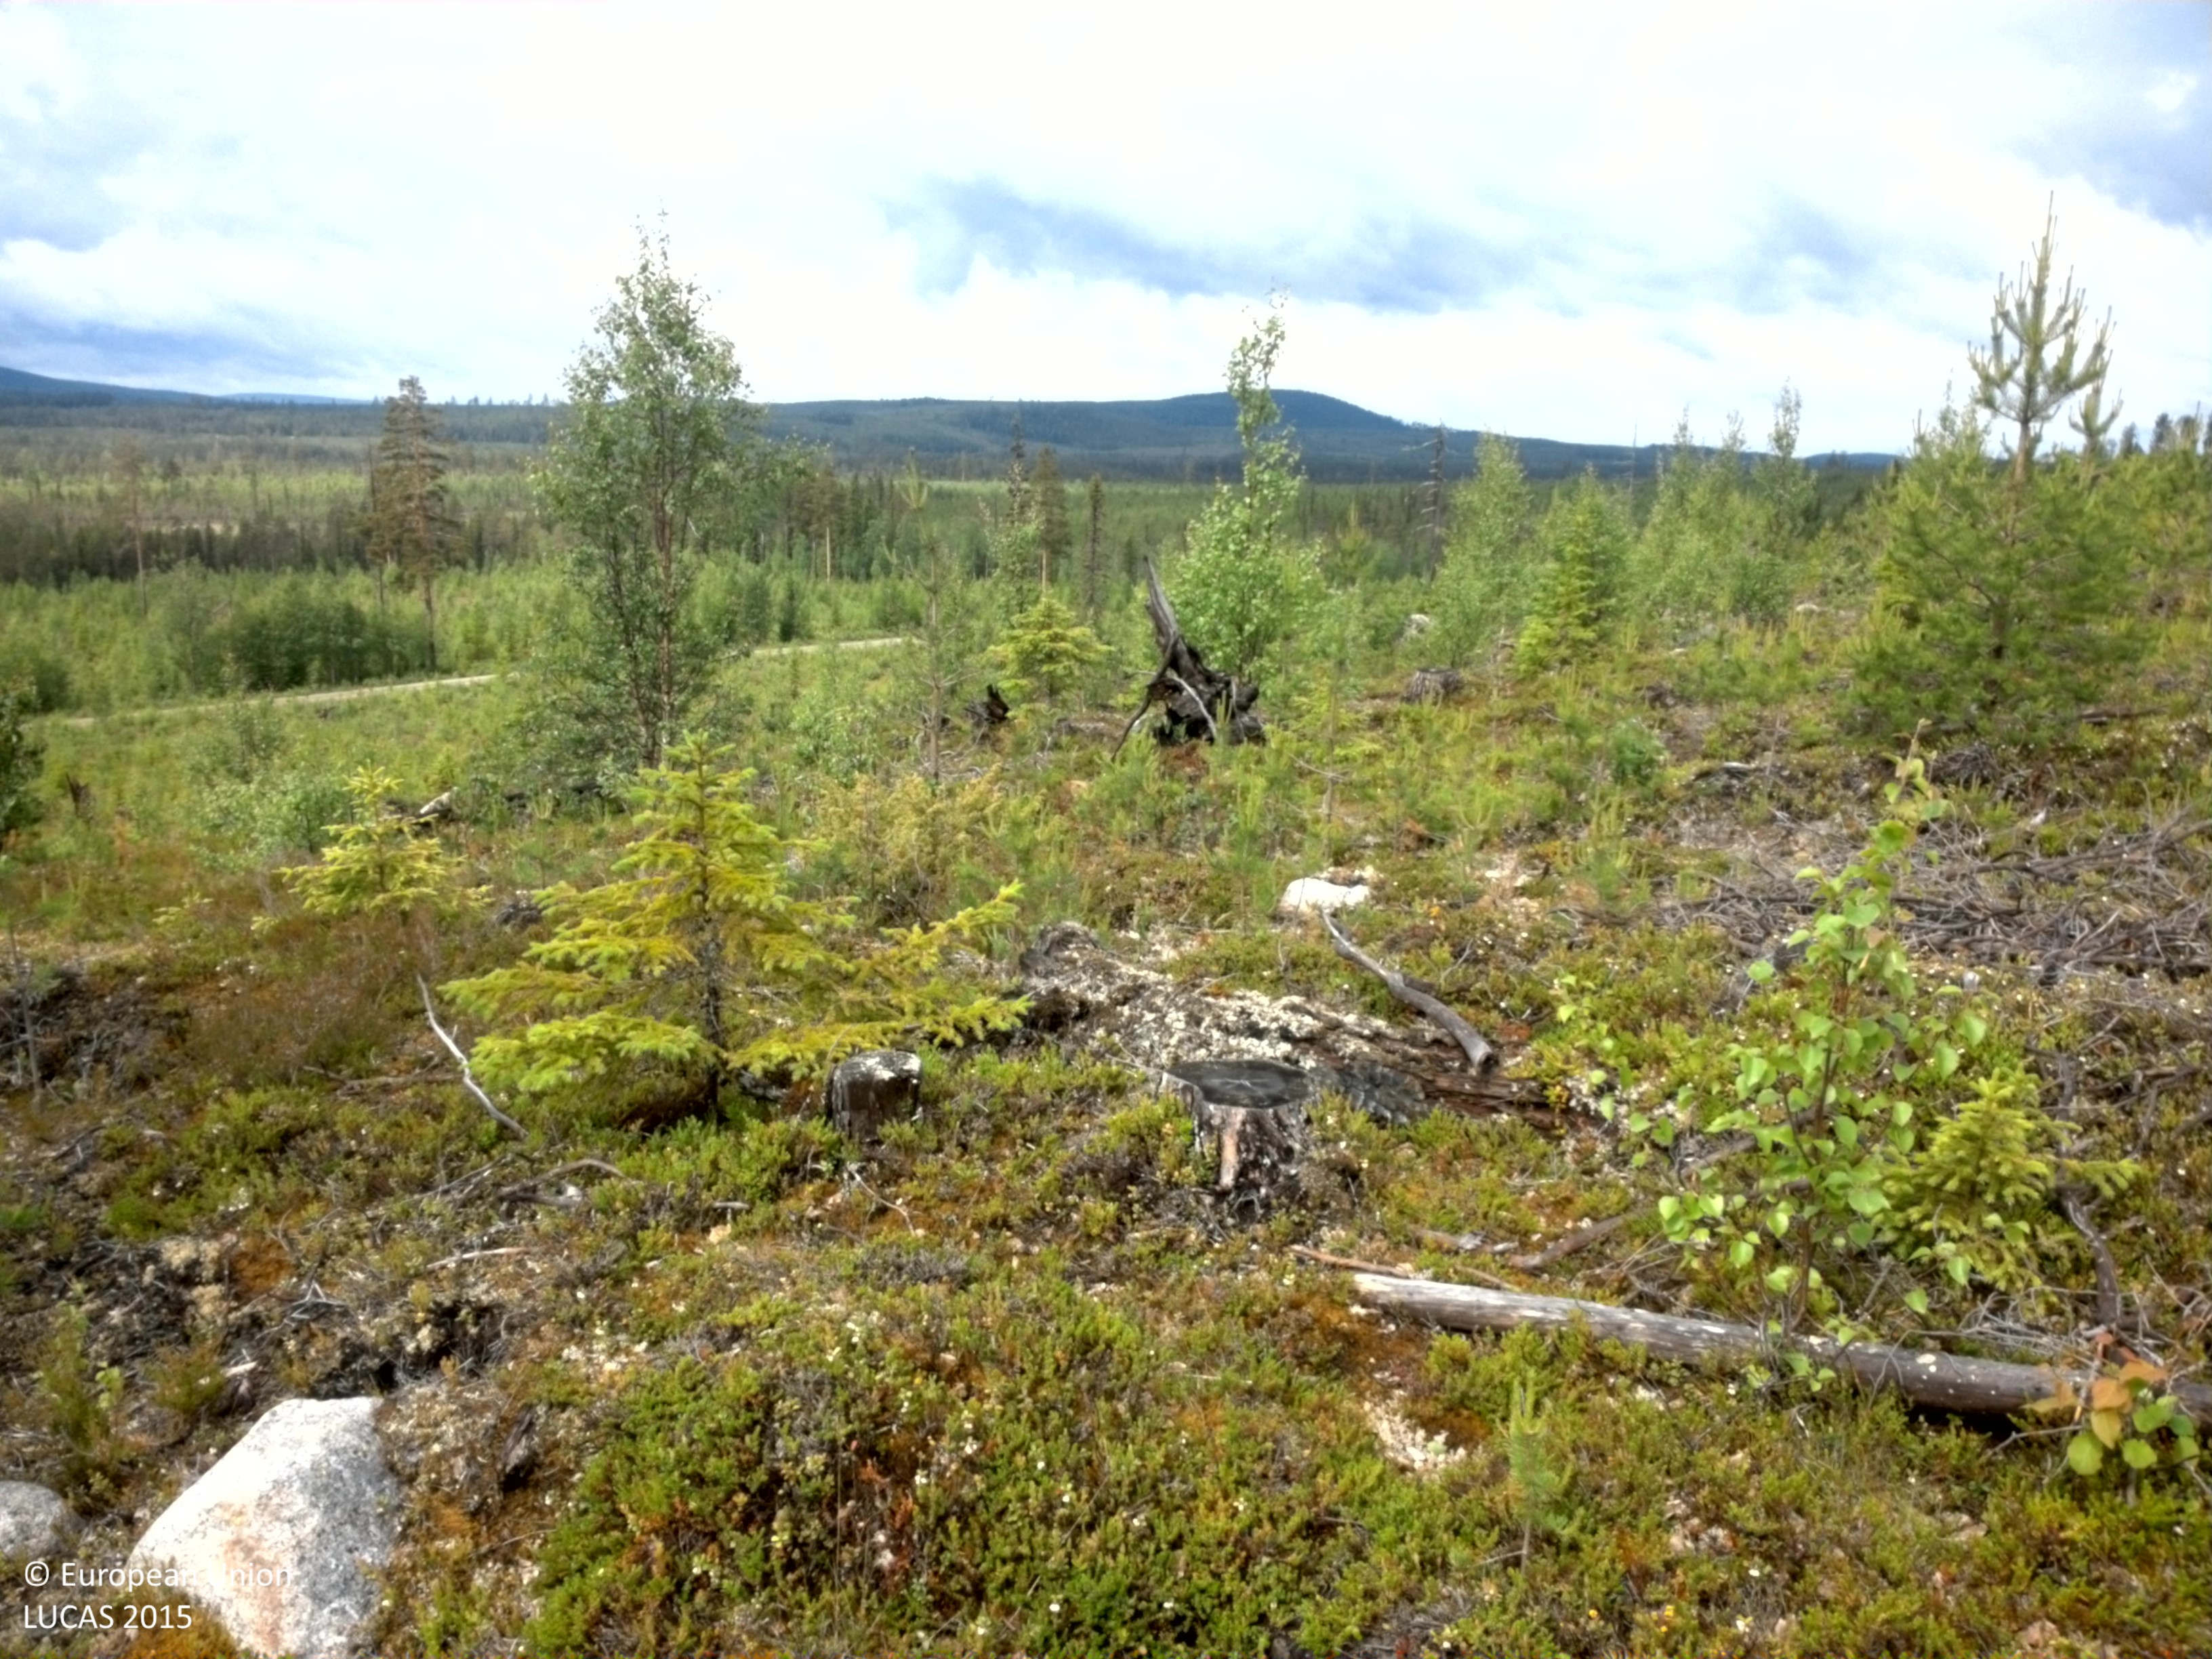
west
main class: Woodland
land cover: Pine dominated mixed woodland
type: boreal forest
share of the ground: 10 - 25 %
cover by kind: shrubs 50 %, lichens and mosses 30 %, coniferous forest trees 15 %, broadleaved forest trees 5 %
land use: Forestry
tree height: < 5 m
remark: Clear cut
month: July
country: SE
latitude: 64.6565
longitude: 18.2373
